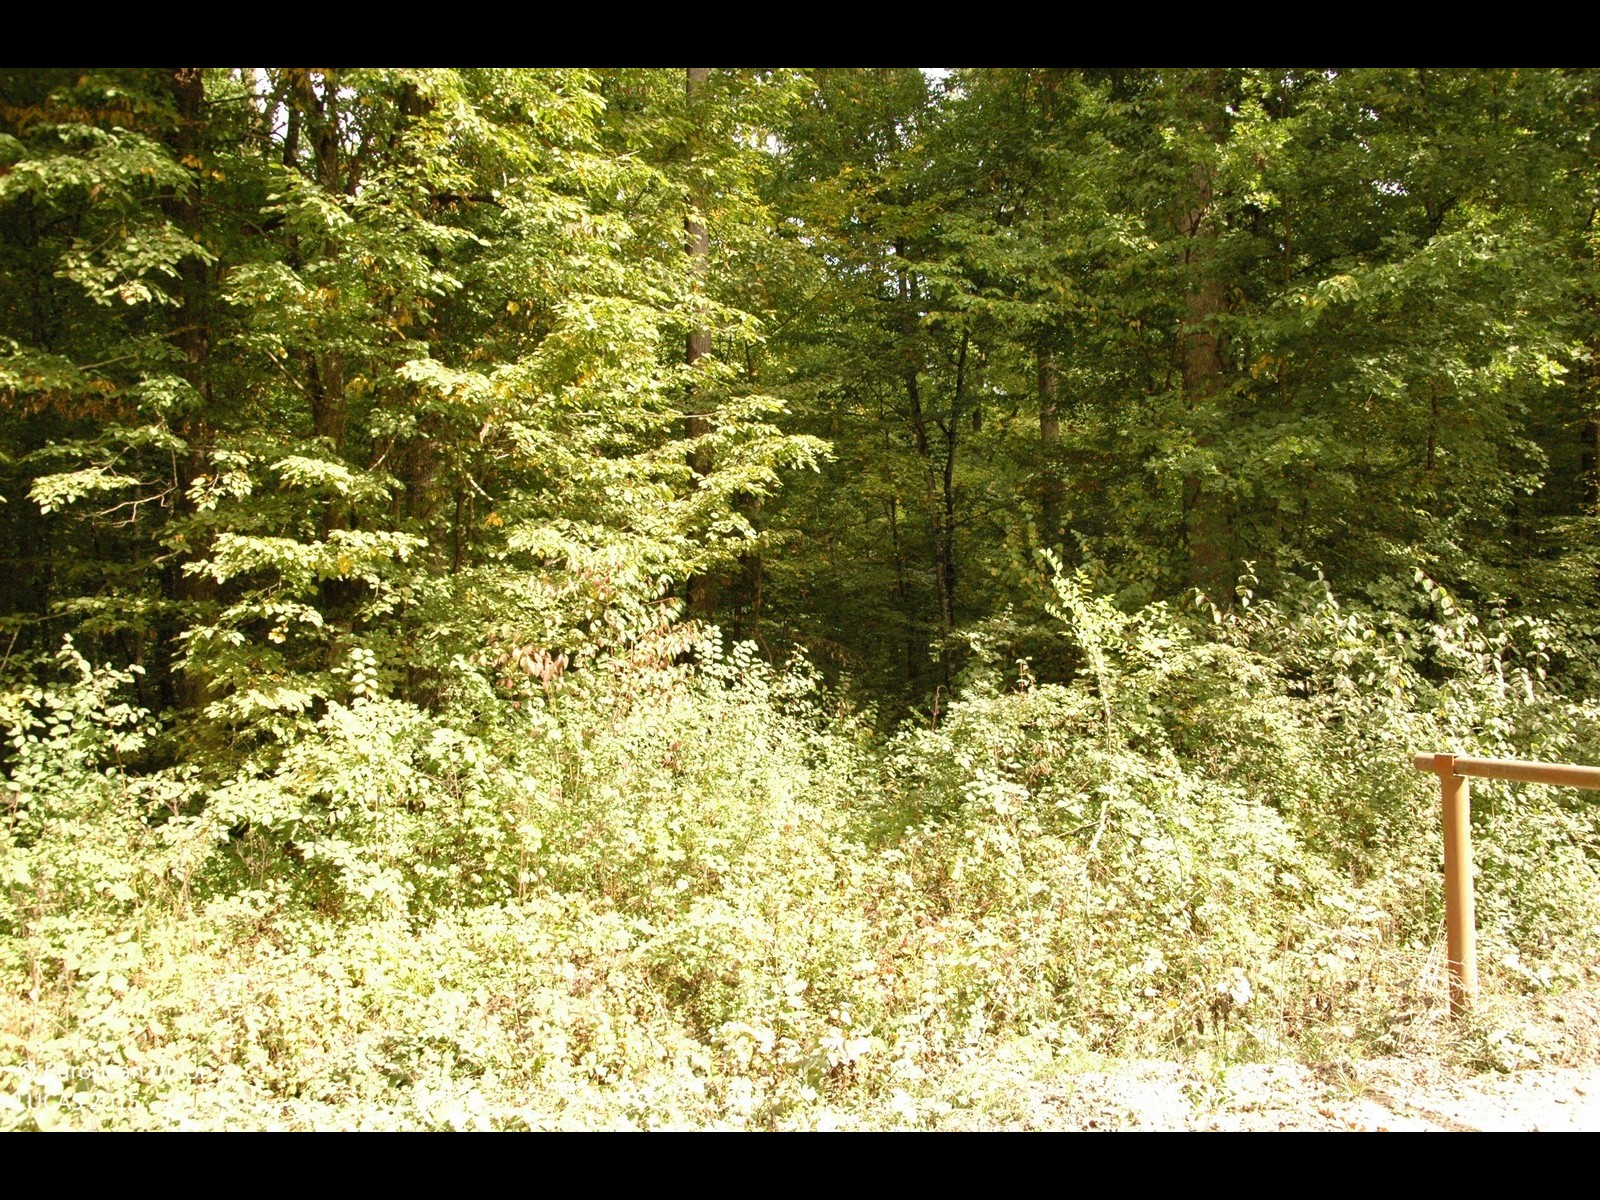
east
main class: Woodland
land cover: Broadleaved woodland
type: mesophytic deciduous forest
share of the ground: > 75 %
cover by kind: broadleaved forest trees 100 %
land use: Forestry
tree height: > 5 m
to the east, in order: Broadleaved woodland; Tracks; Broadleaved woodland
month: September
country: HR
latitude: 45.6282
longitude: 16.2189
